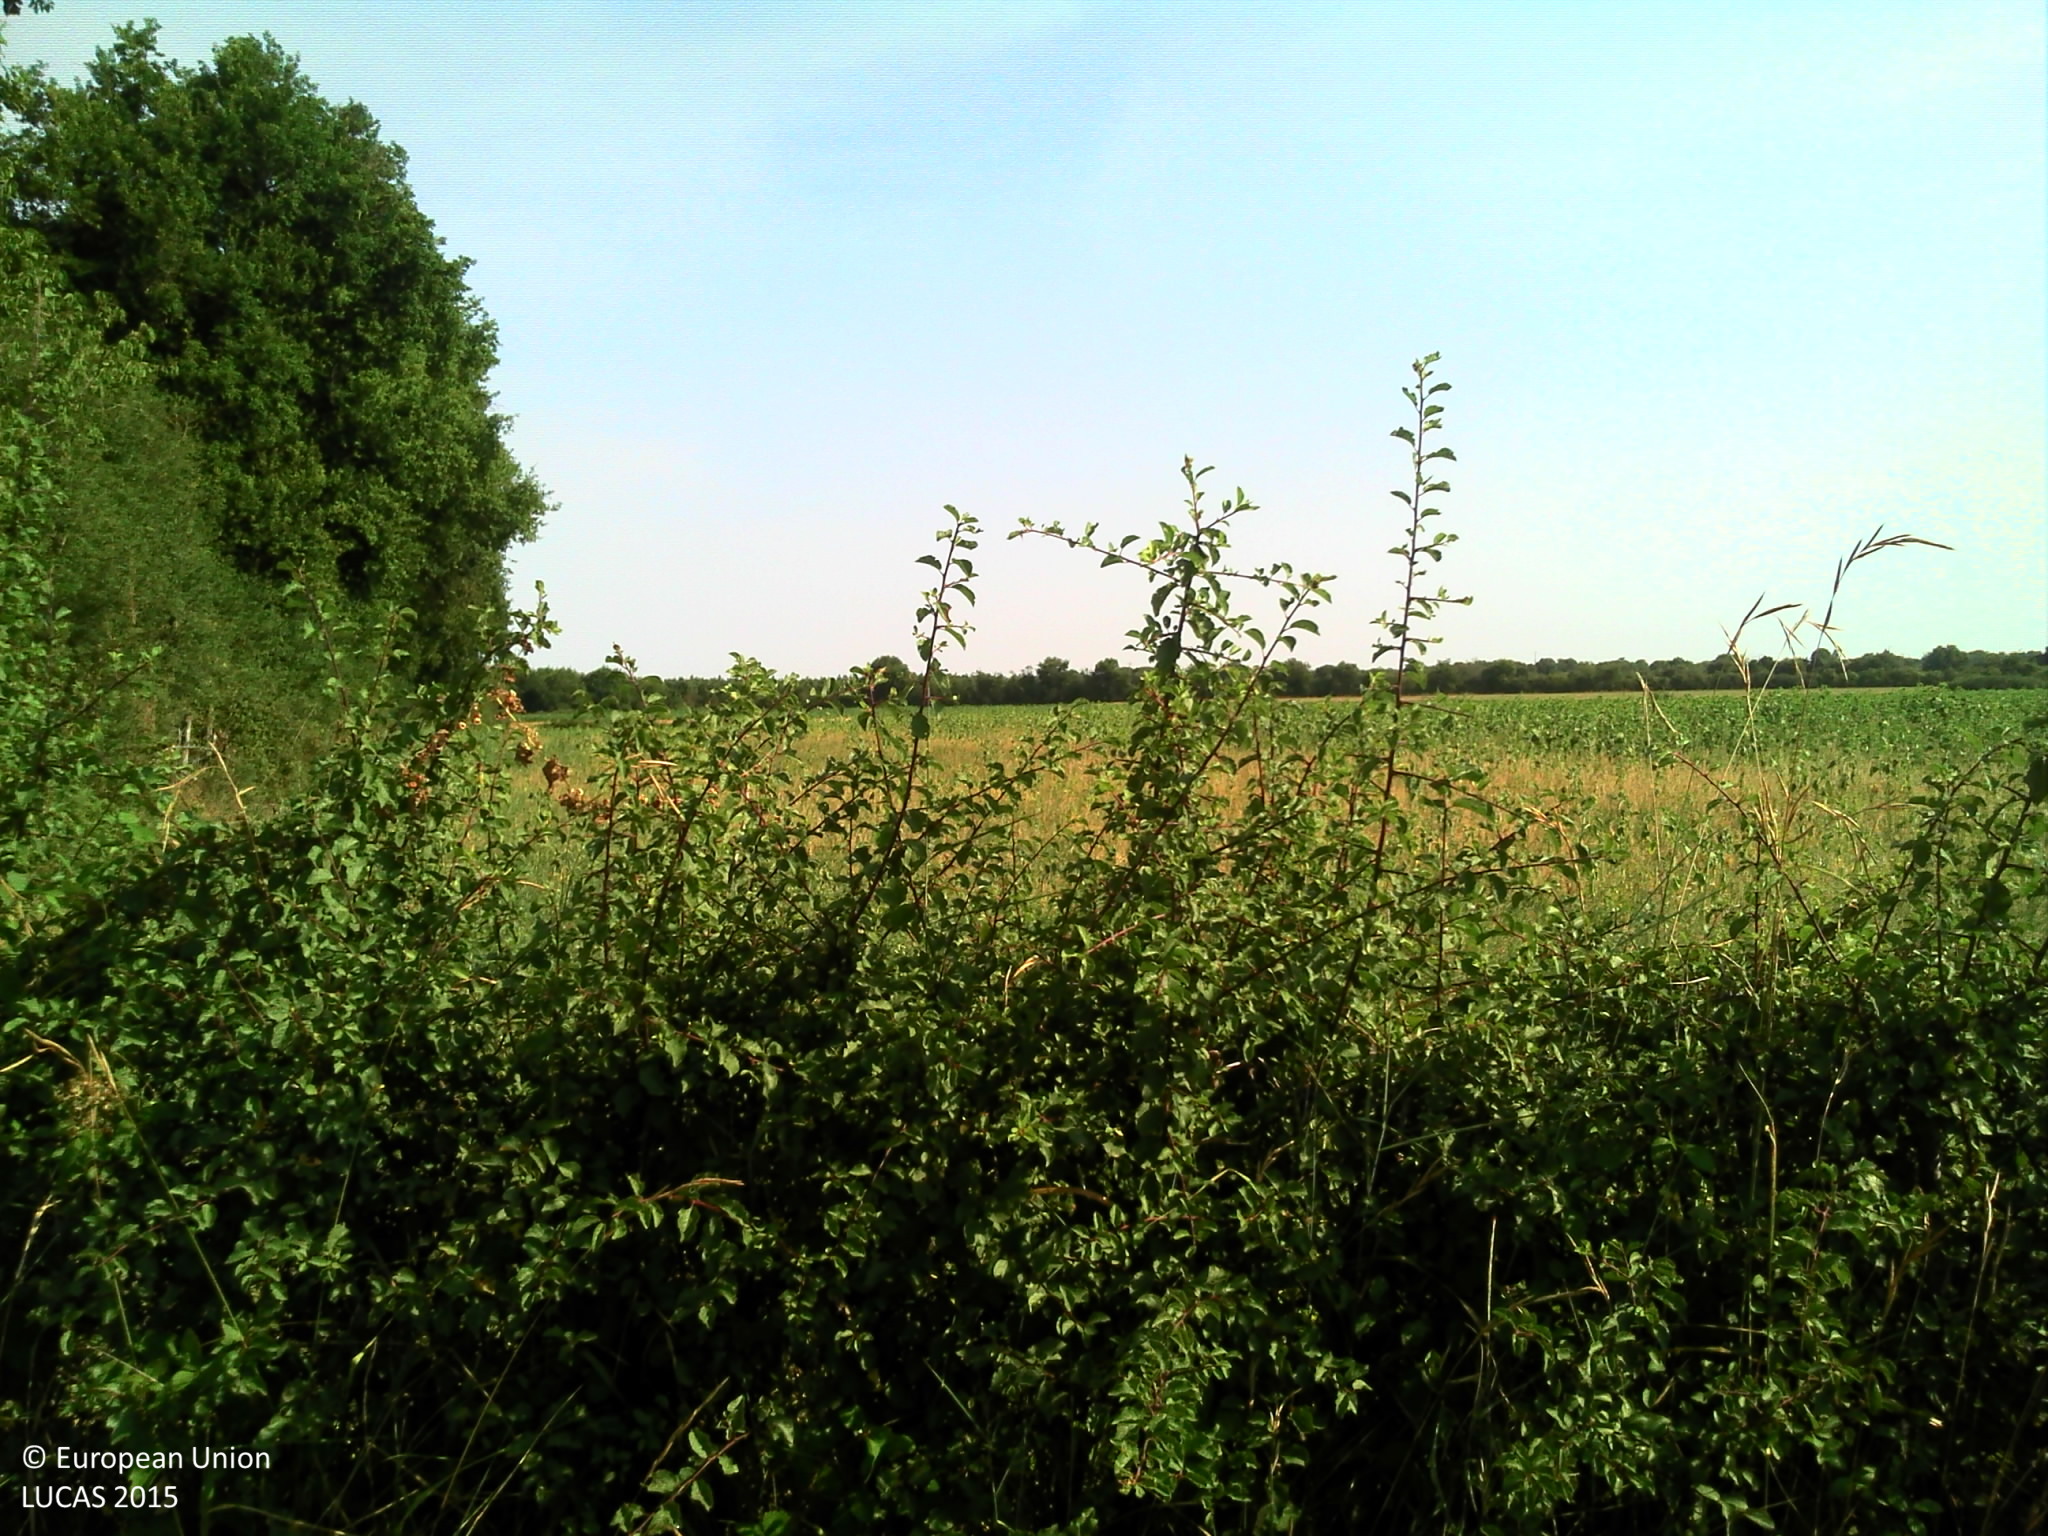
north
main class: Cropland
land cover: Sunflower
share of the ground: > 75 %
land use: Agriculture (excluding fallow land and kitchen gardens)
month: July
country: FR
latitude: 46.1917
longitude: 0.6167
